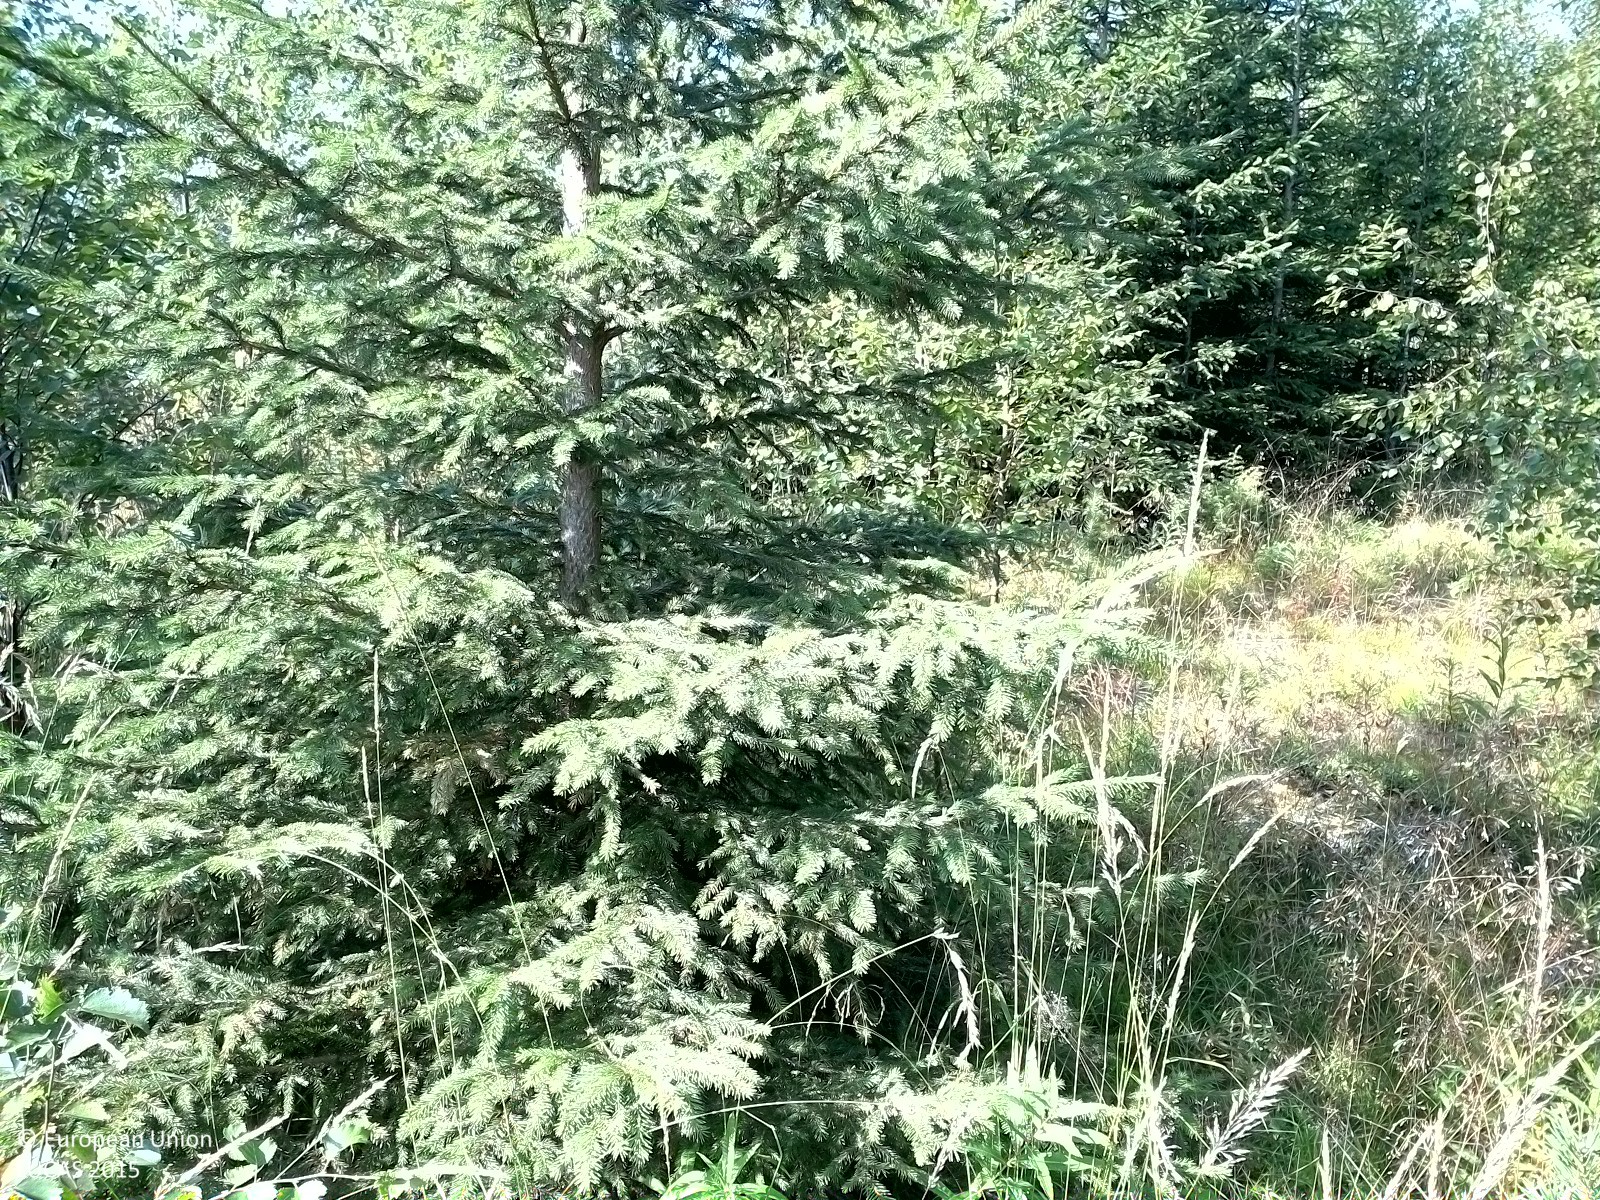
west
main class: Woodland
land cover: Other mixed woodland
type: boreal forest
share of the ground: 50 - 75 %
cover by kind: herbaceous plants 40 %, coniferous forest trees 35 %, broadleaved forest trees 20 %, shrubs 5 %
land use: Forestry
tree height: < 5 m
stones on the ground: < 10 %
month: August
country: SE
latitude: 62.4453
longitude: 16.2770
